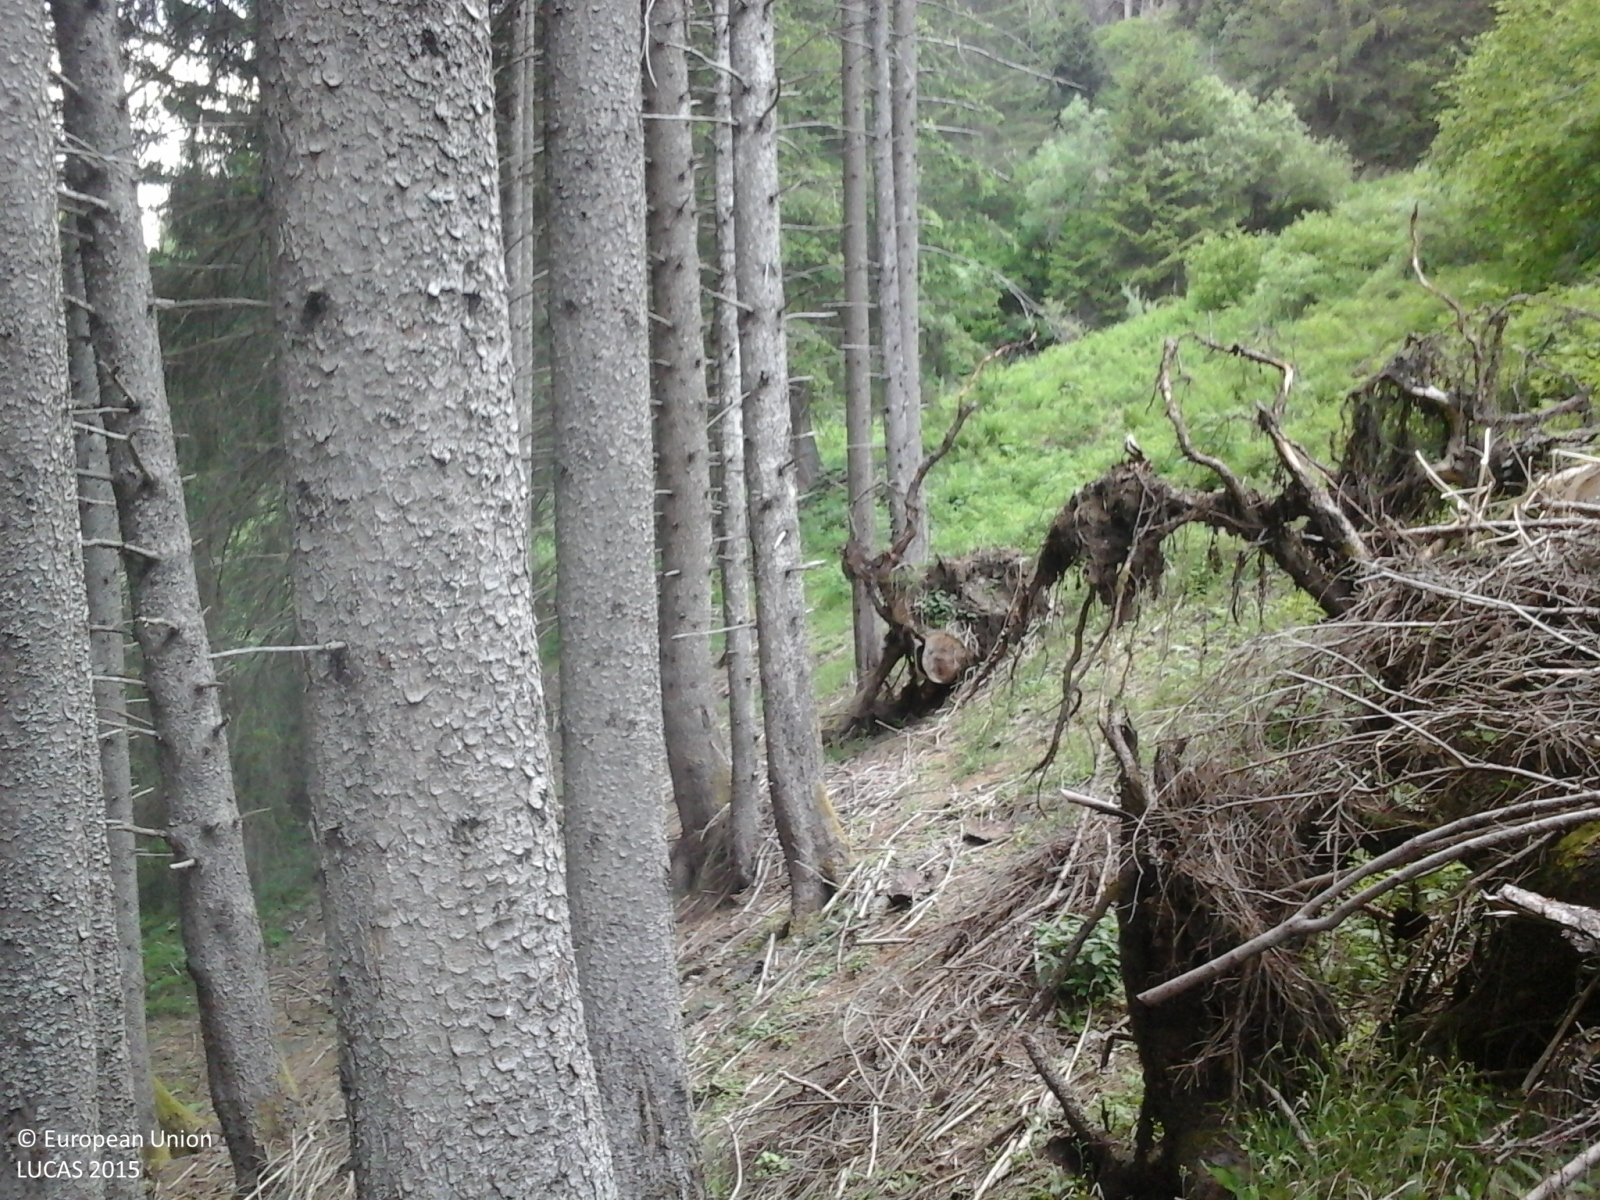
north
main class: Woodland
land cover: Spruce dominated coniferous woodland
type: alpine coniferous forest
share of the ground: > 75 %
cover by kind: coniferous forest trees 100 %
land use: Semi-natural and natural areas not in use
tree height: > 5 m
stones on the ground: 10 - 25 %
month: June
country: IT
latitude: 46.2240
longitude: 10.4790
